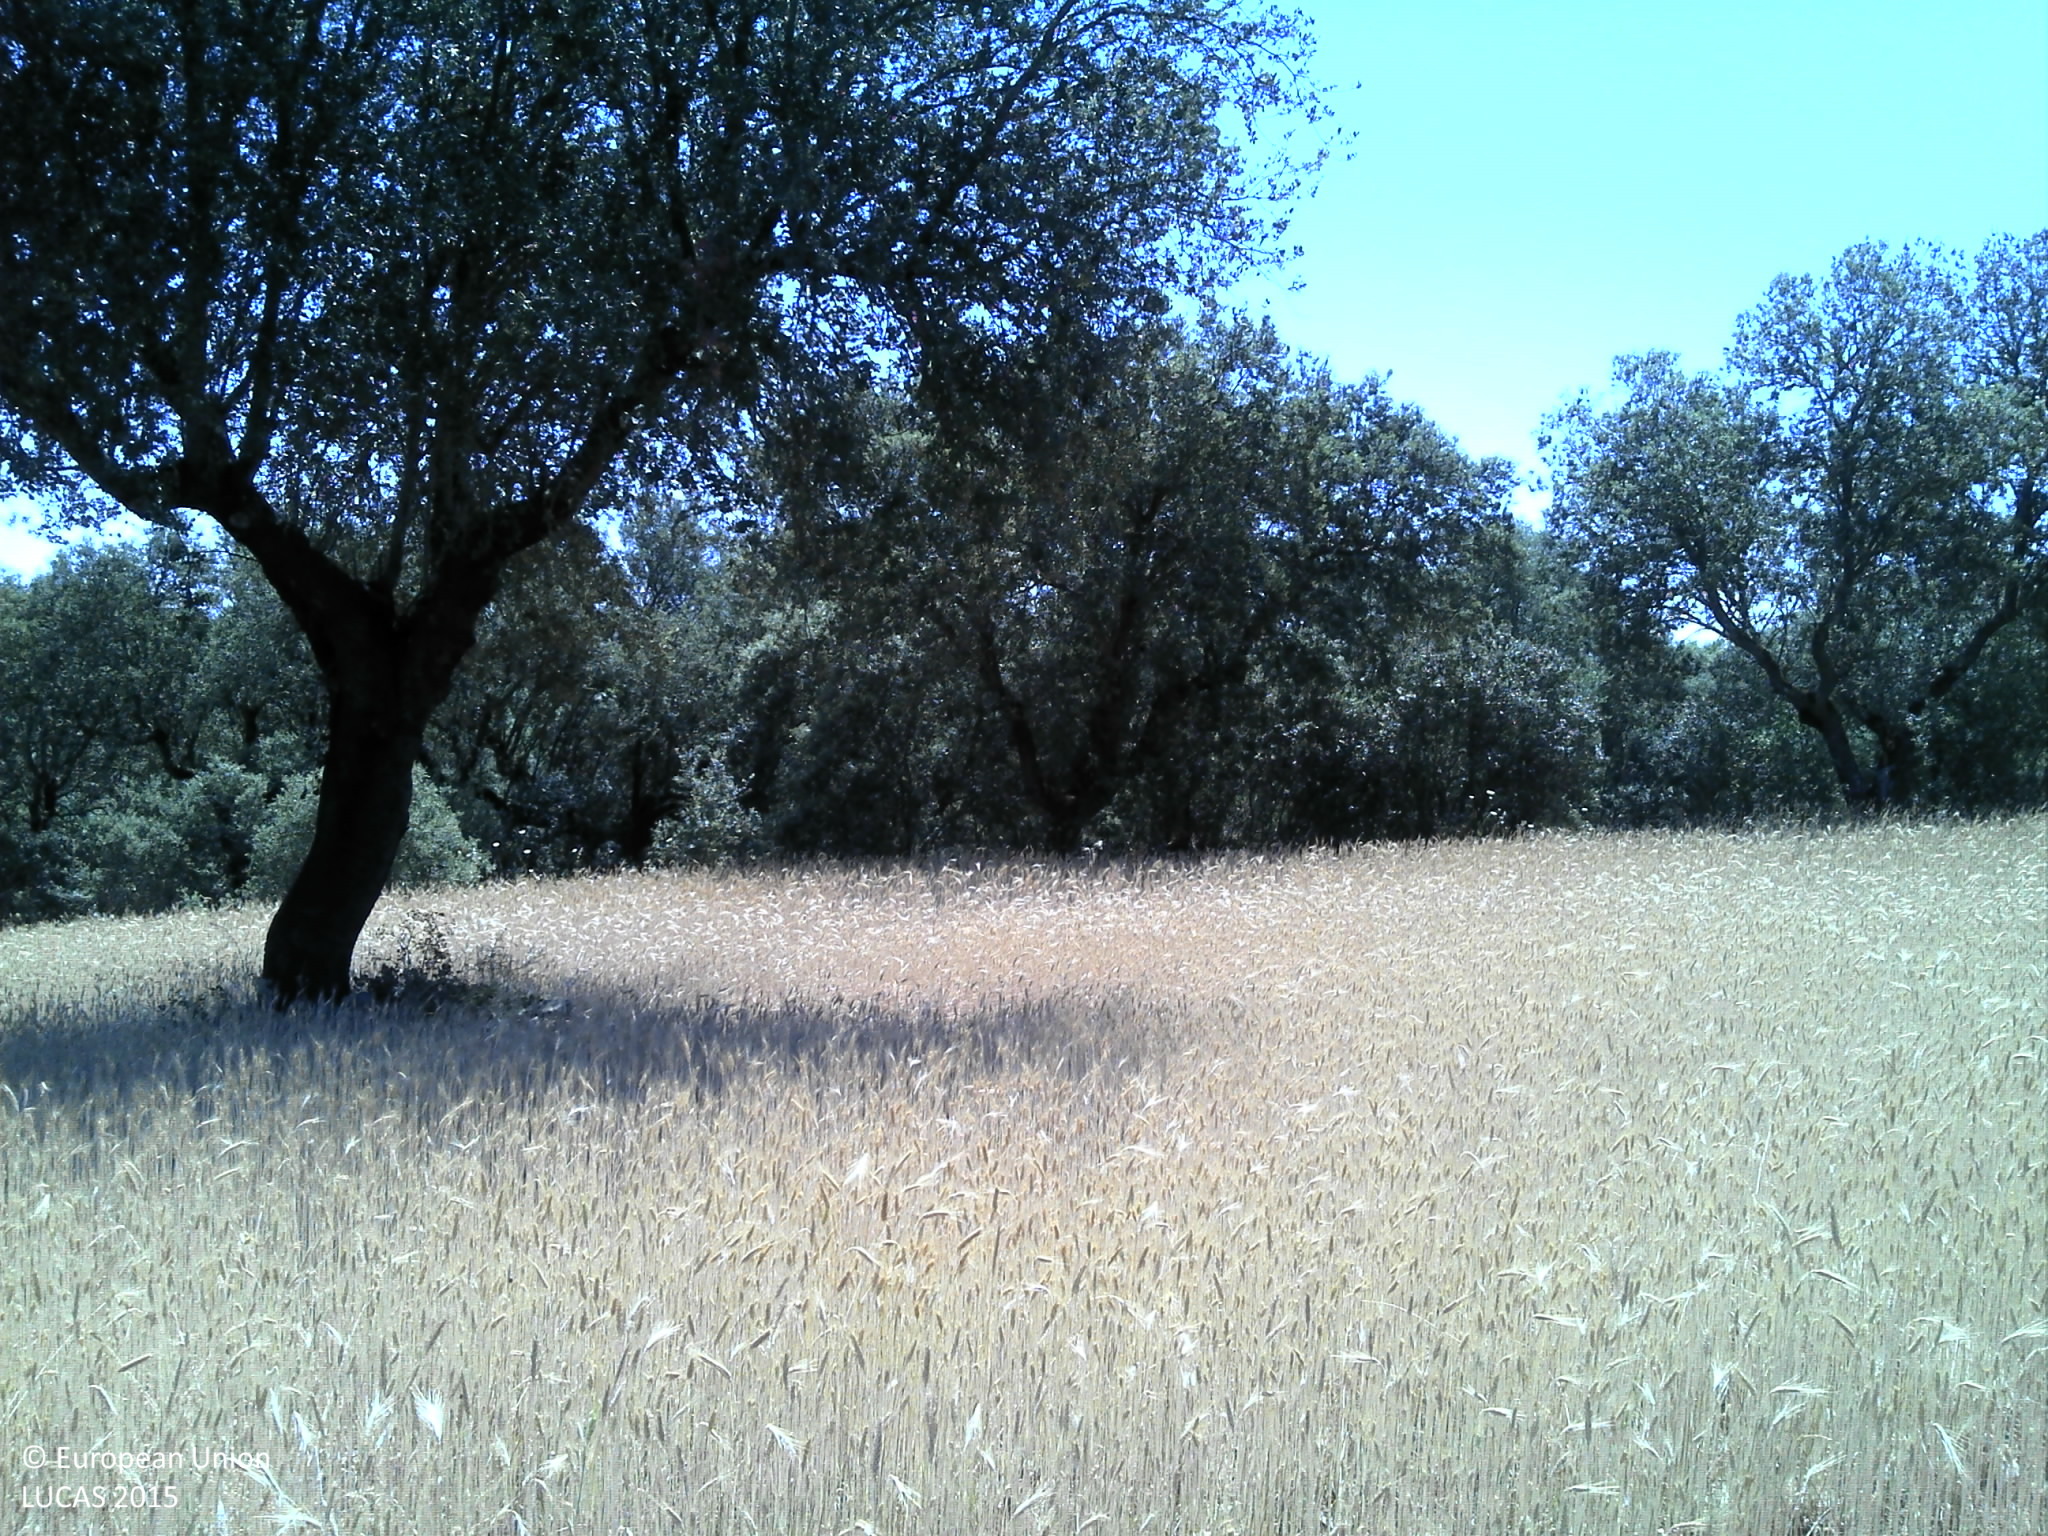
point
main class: Woodland
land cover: Broadleaved woodland
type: broadleaved evergreen forest
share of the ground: 25 - 50 %
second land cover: Triticale
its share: 50 - 75 %
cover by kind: herbaceous plants 60 %, broadleaved forest trees 30 %, unconsolidated bare surface 10 %
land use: Forestry
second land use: Agriculture (excluding fallow land and kitchen gardens)
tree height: > 5 m
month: May
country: PT
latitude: 39.0160
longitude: -7.5834
